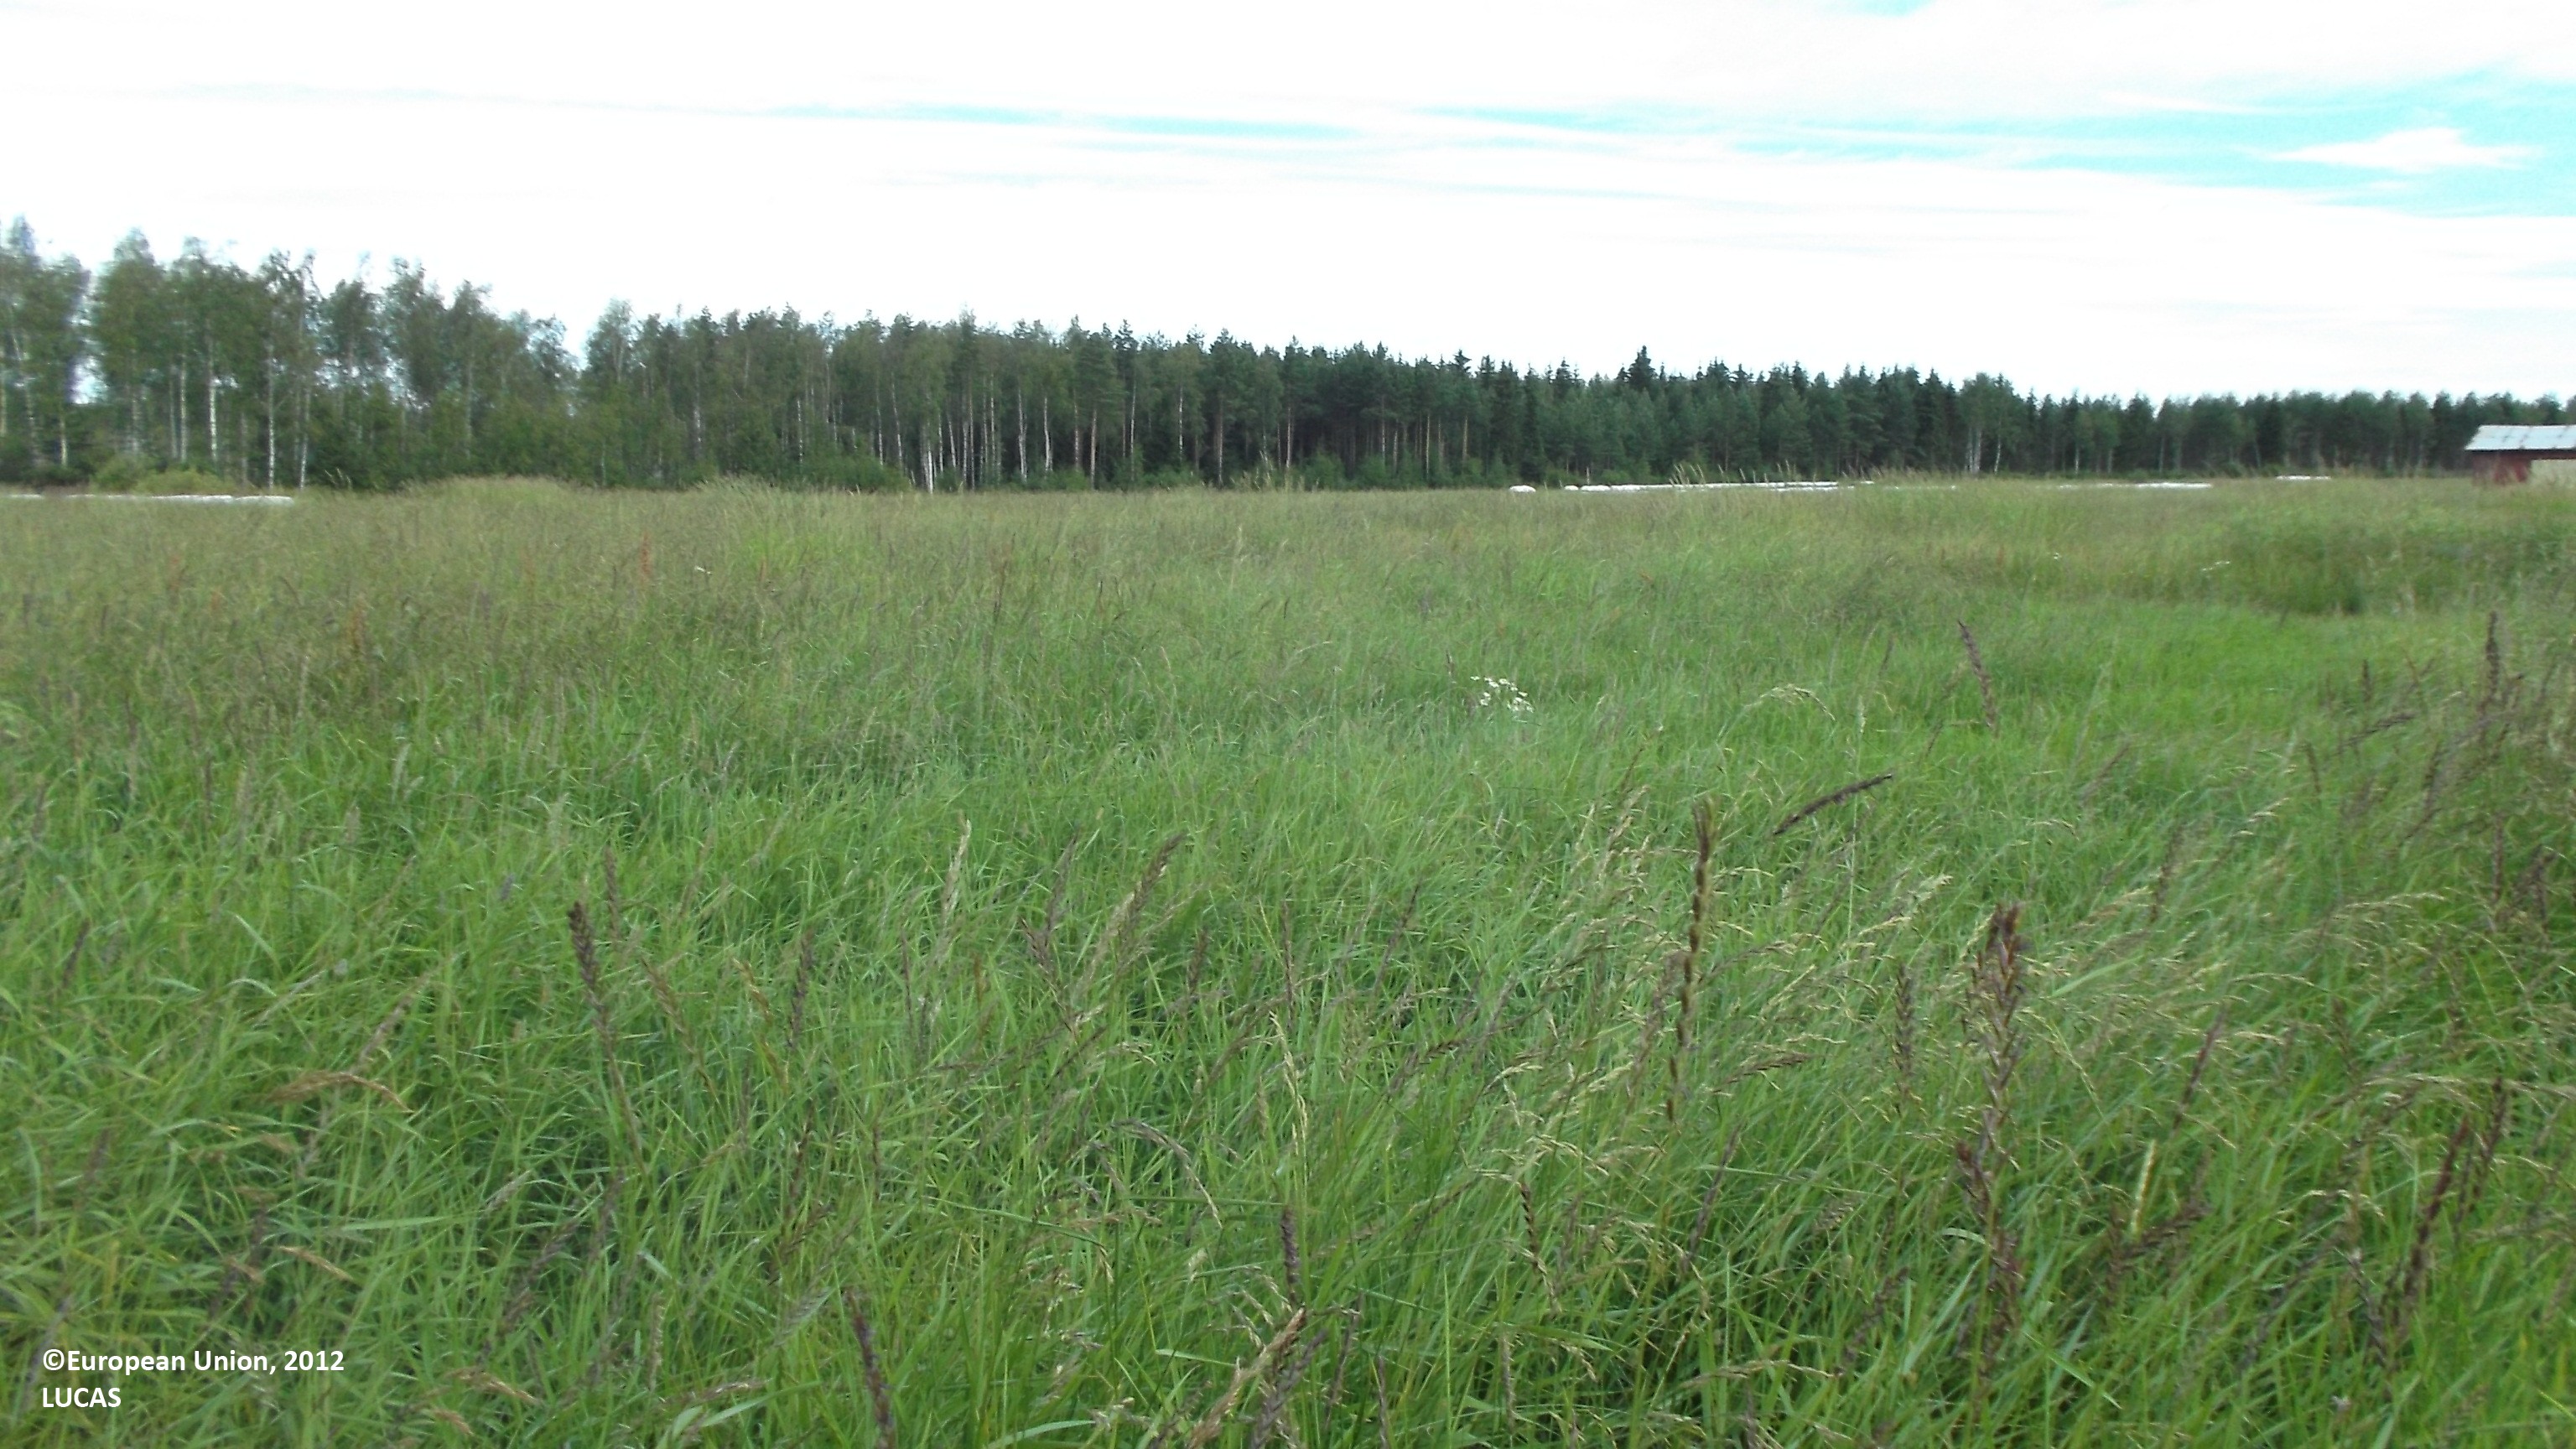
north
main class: Grassland
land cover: Spontaneously vegetated surfaces
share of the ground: > 75 %
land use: Fallow land
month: July
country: FI
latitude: 64.0026
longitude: 23.4910
